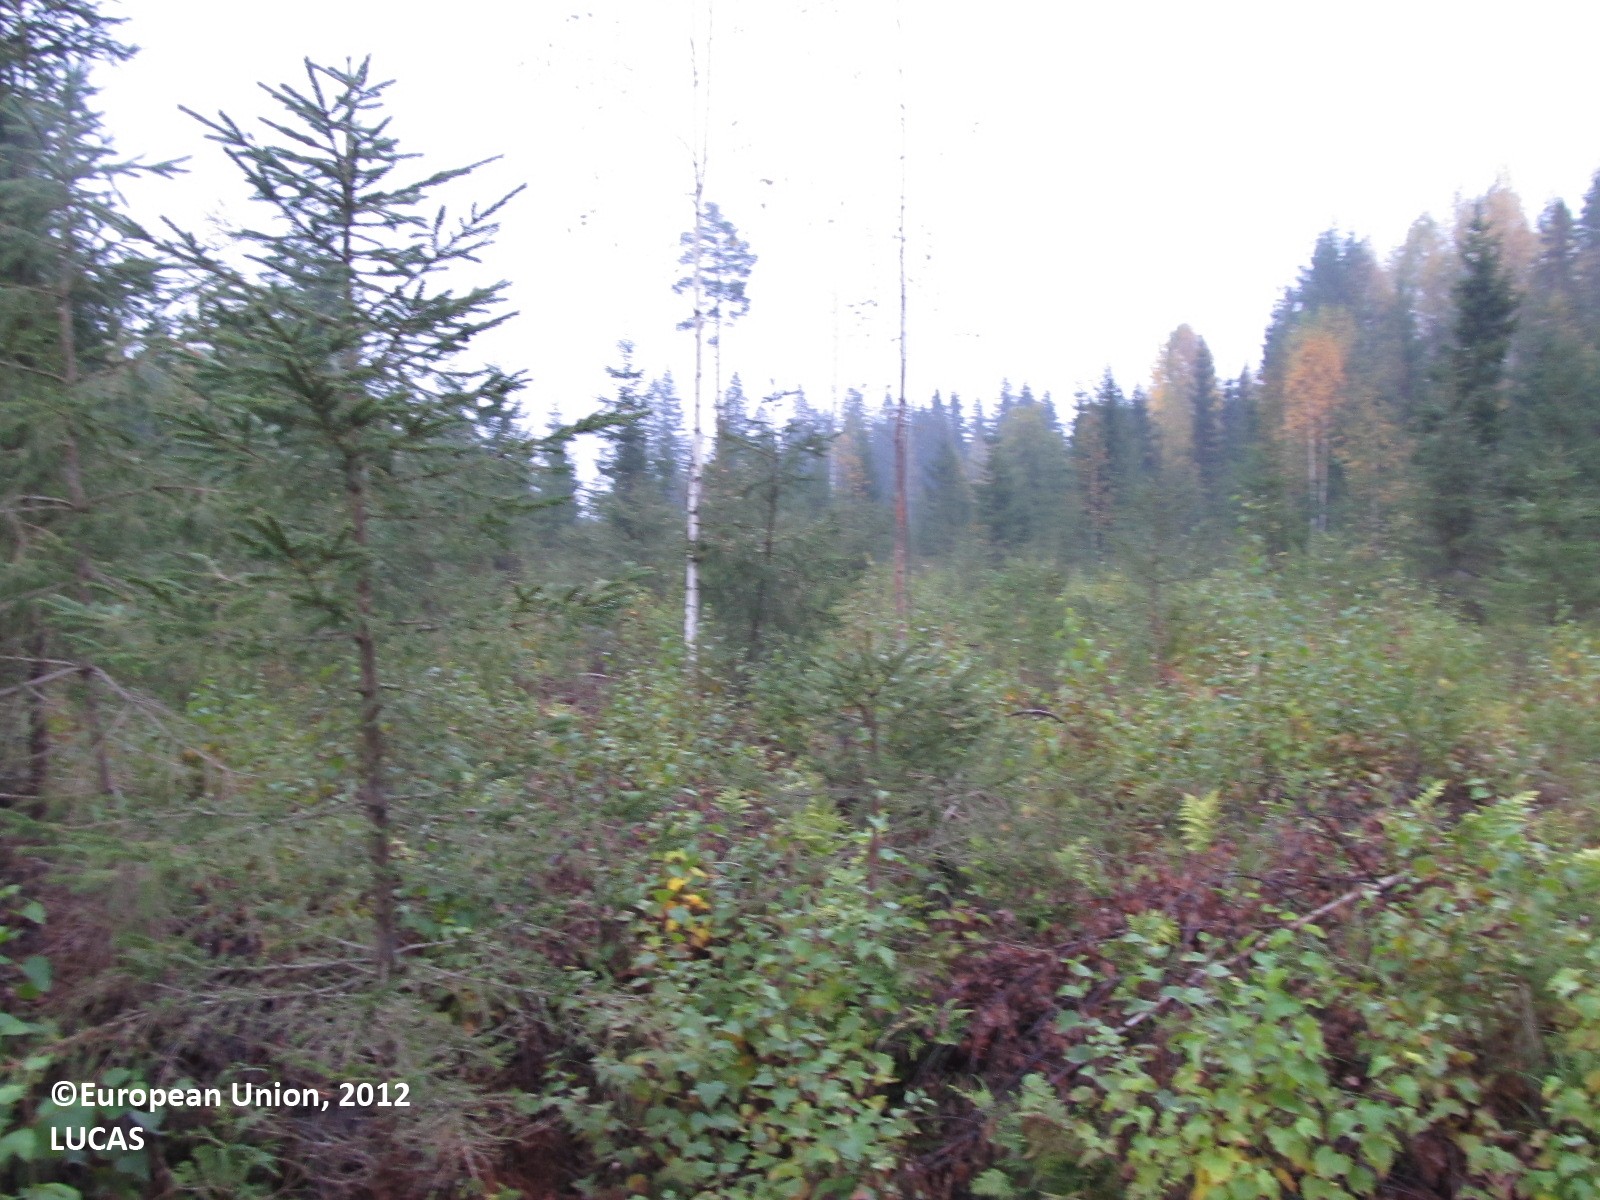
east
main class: Woodland
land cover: Spruce dominated mixed woodland
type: boreal forest
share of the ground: 50 - 75 %
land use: Forestry
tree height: < 5 m
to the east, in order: Spruce dominated mixed woodland; Spruce dominated coniferous woodland; Ditches and canals; Paved roads, cycling and walking lanes; Ditches and canals; Spruce dominated coniferous woodland; Electric lines; Spruce dominated coniferous woodland
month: September
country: FI
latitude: 62.2855
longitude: 28.2149
